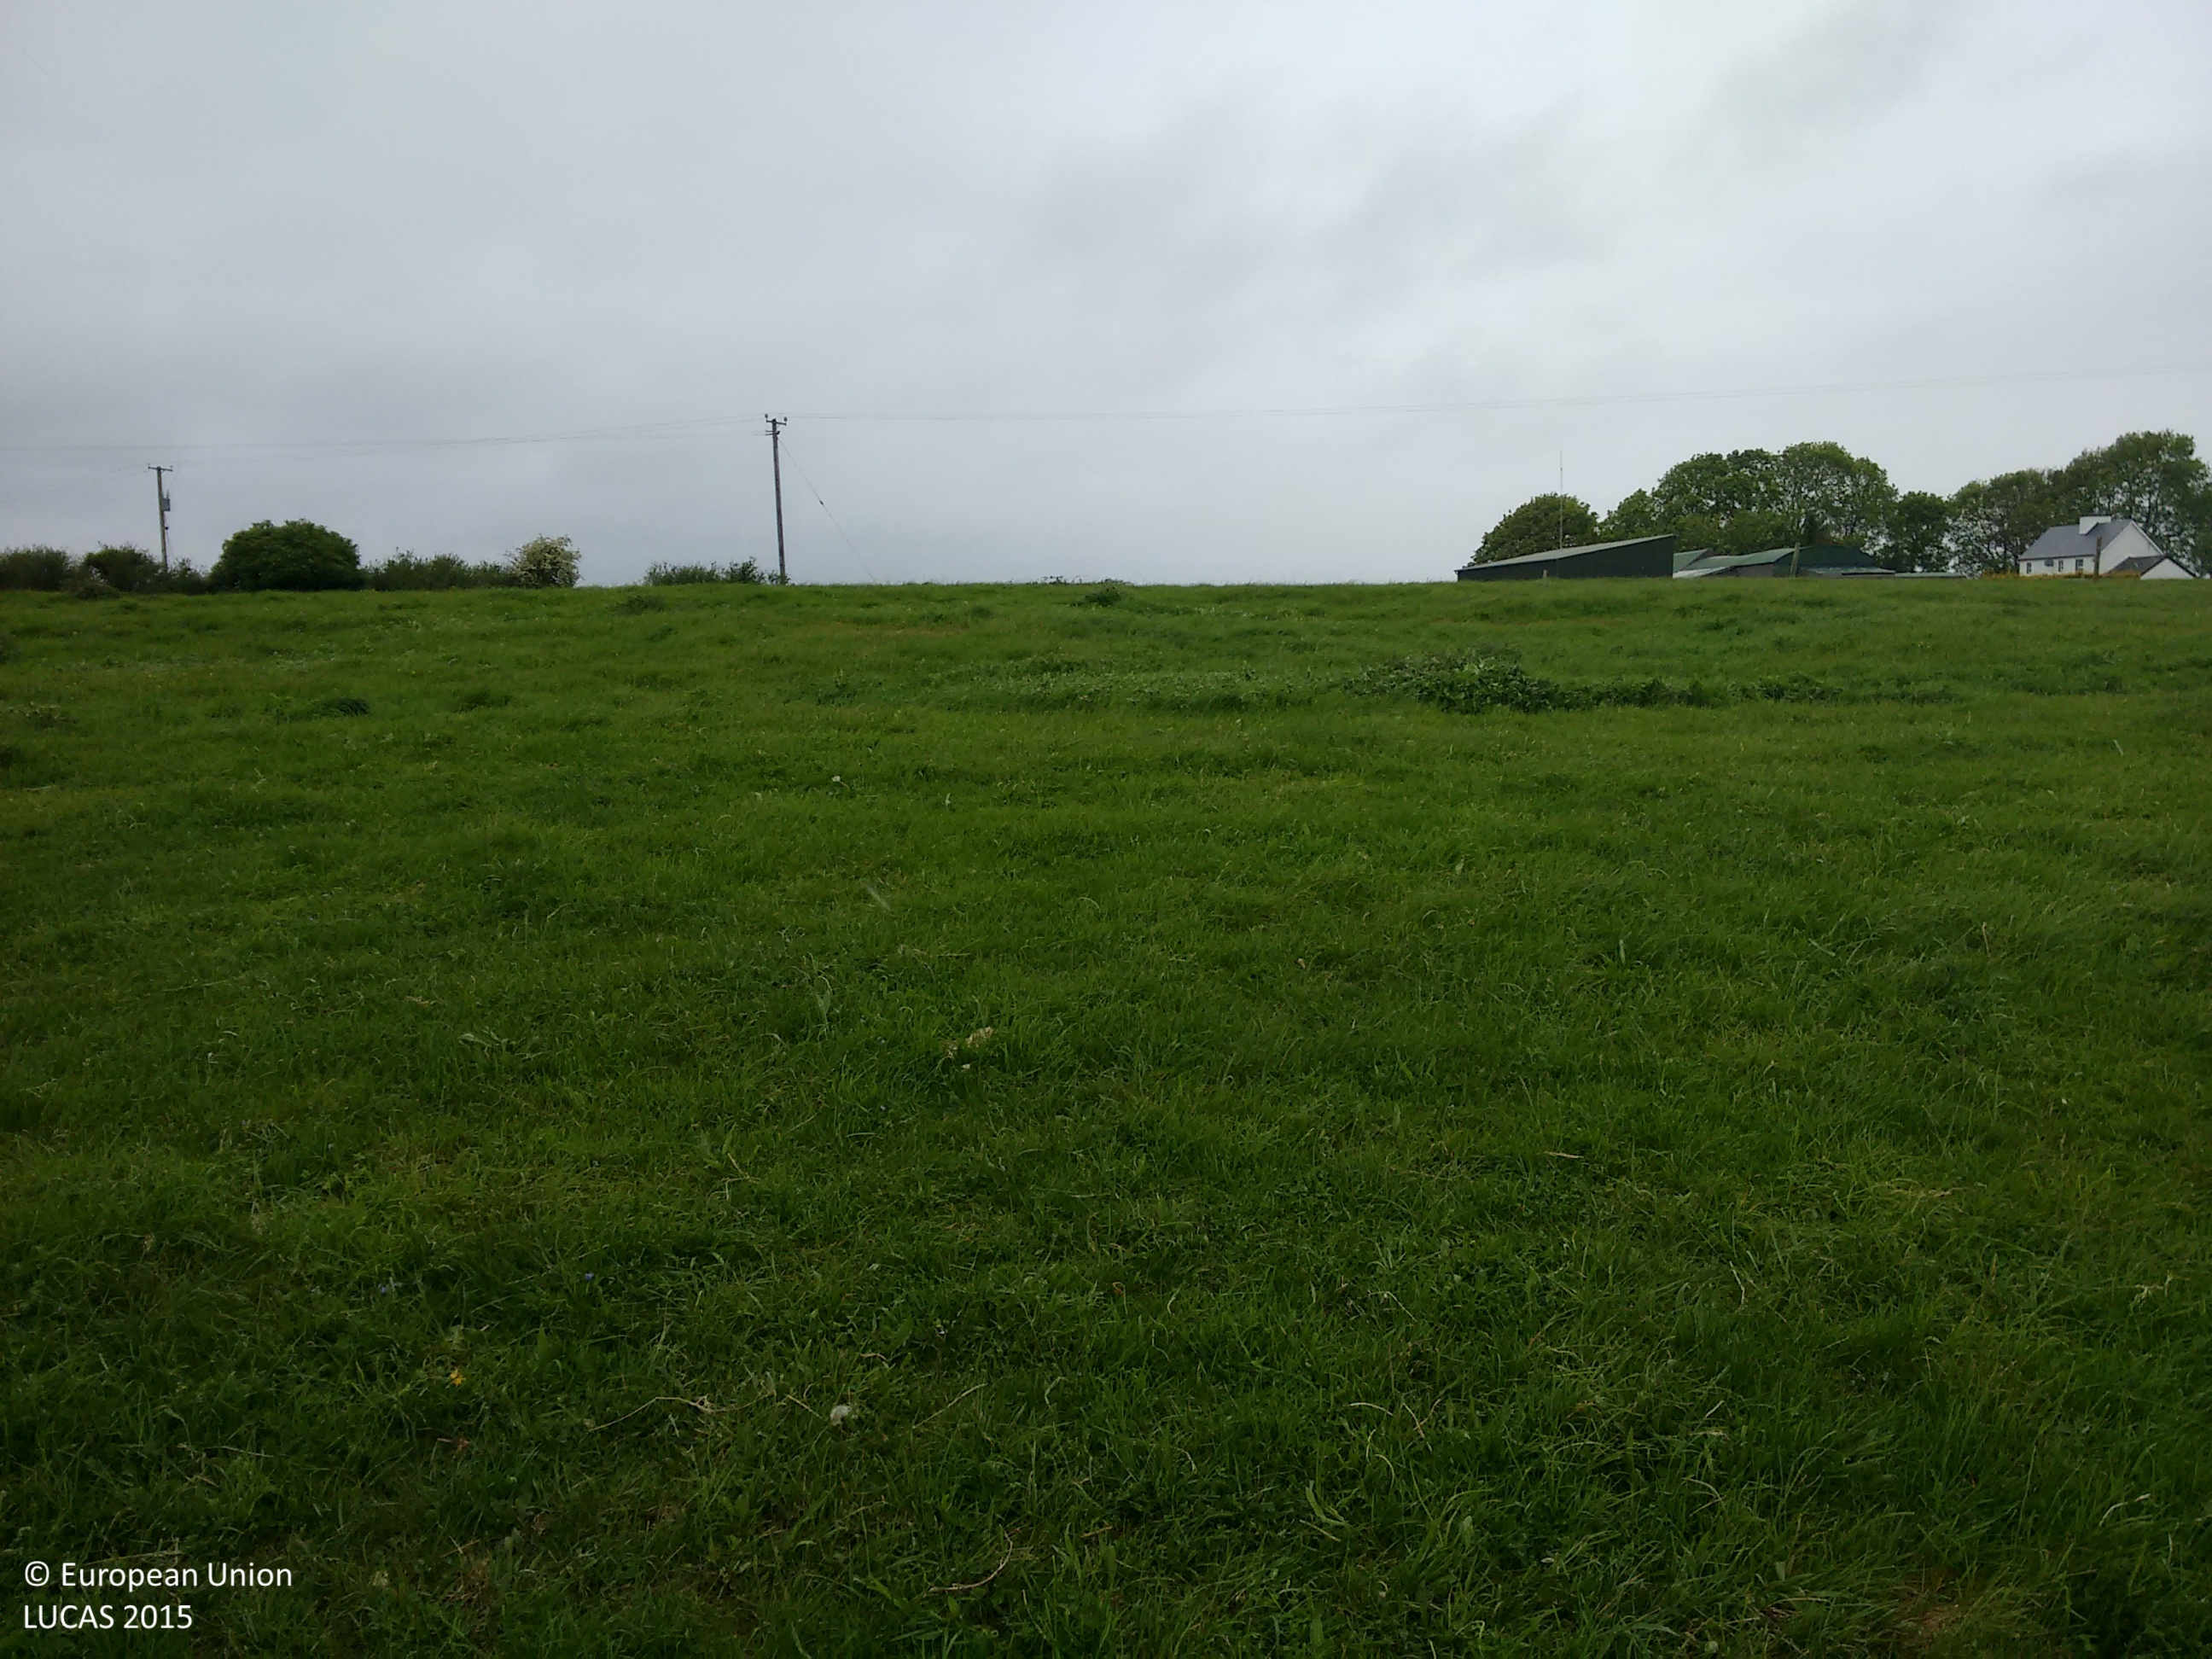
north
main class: Grassland
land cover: Grassland without tree/shrub cover
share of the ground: > 75 %
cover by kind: herbaceous plants 100 %
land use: Agriculture (excluding fallow land and kitchen gardens)
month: May
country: IE
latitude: 53.1407
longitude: -8.8486
